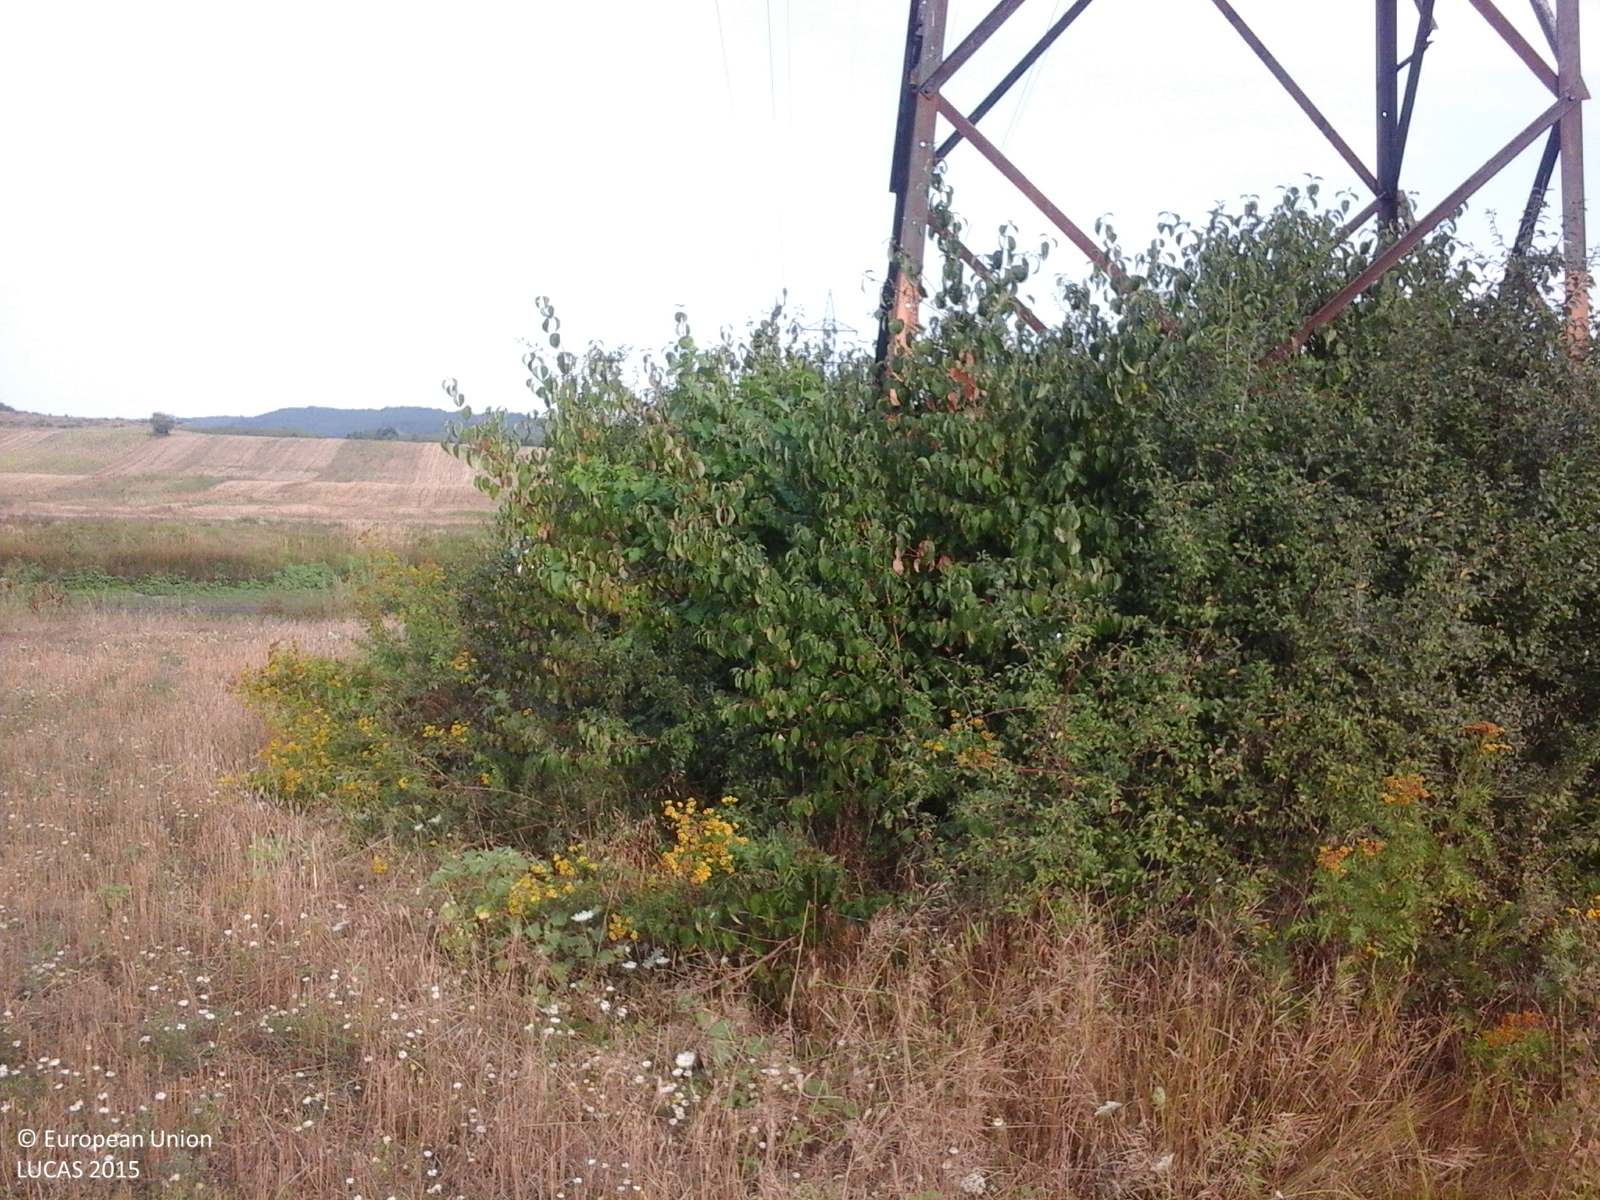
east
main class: Cropland
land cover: Common wheat
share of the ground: > 75 %
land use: Agriculture (excluding fallow land and kitchen gardens)
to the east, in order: Electric lines; Spontaneously vegetated surfaces; Common wheat; Tracks; Abandoned hedges; Inland marshes; Grass margins; Tracks; Spontaneously vegetated surfaces; Common wheat
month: August
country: RO
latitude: 44.7252
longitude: 23.6299
